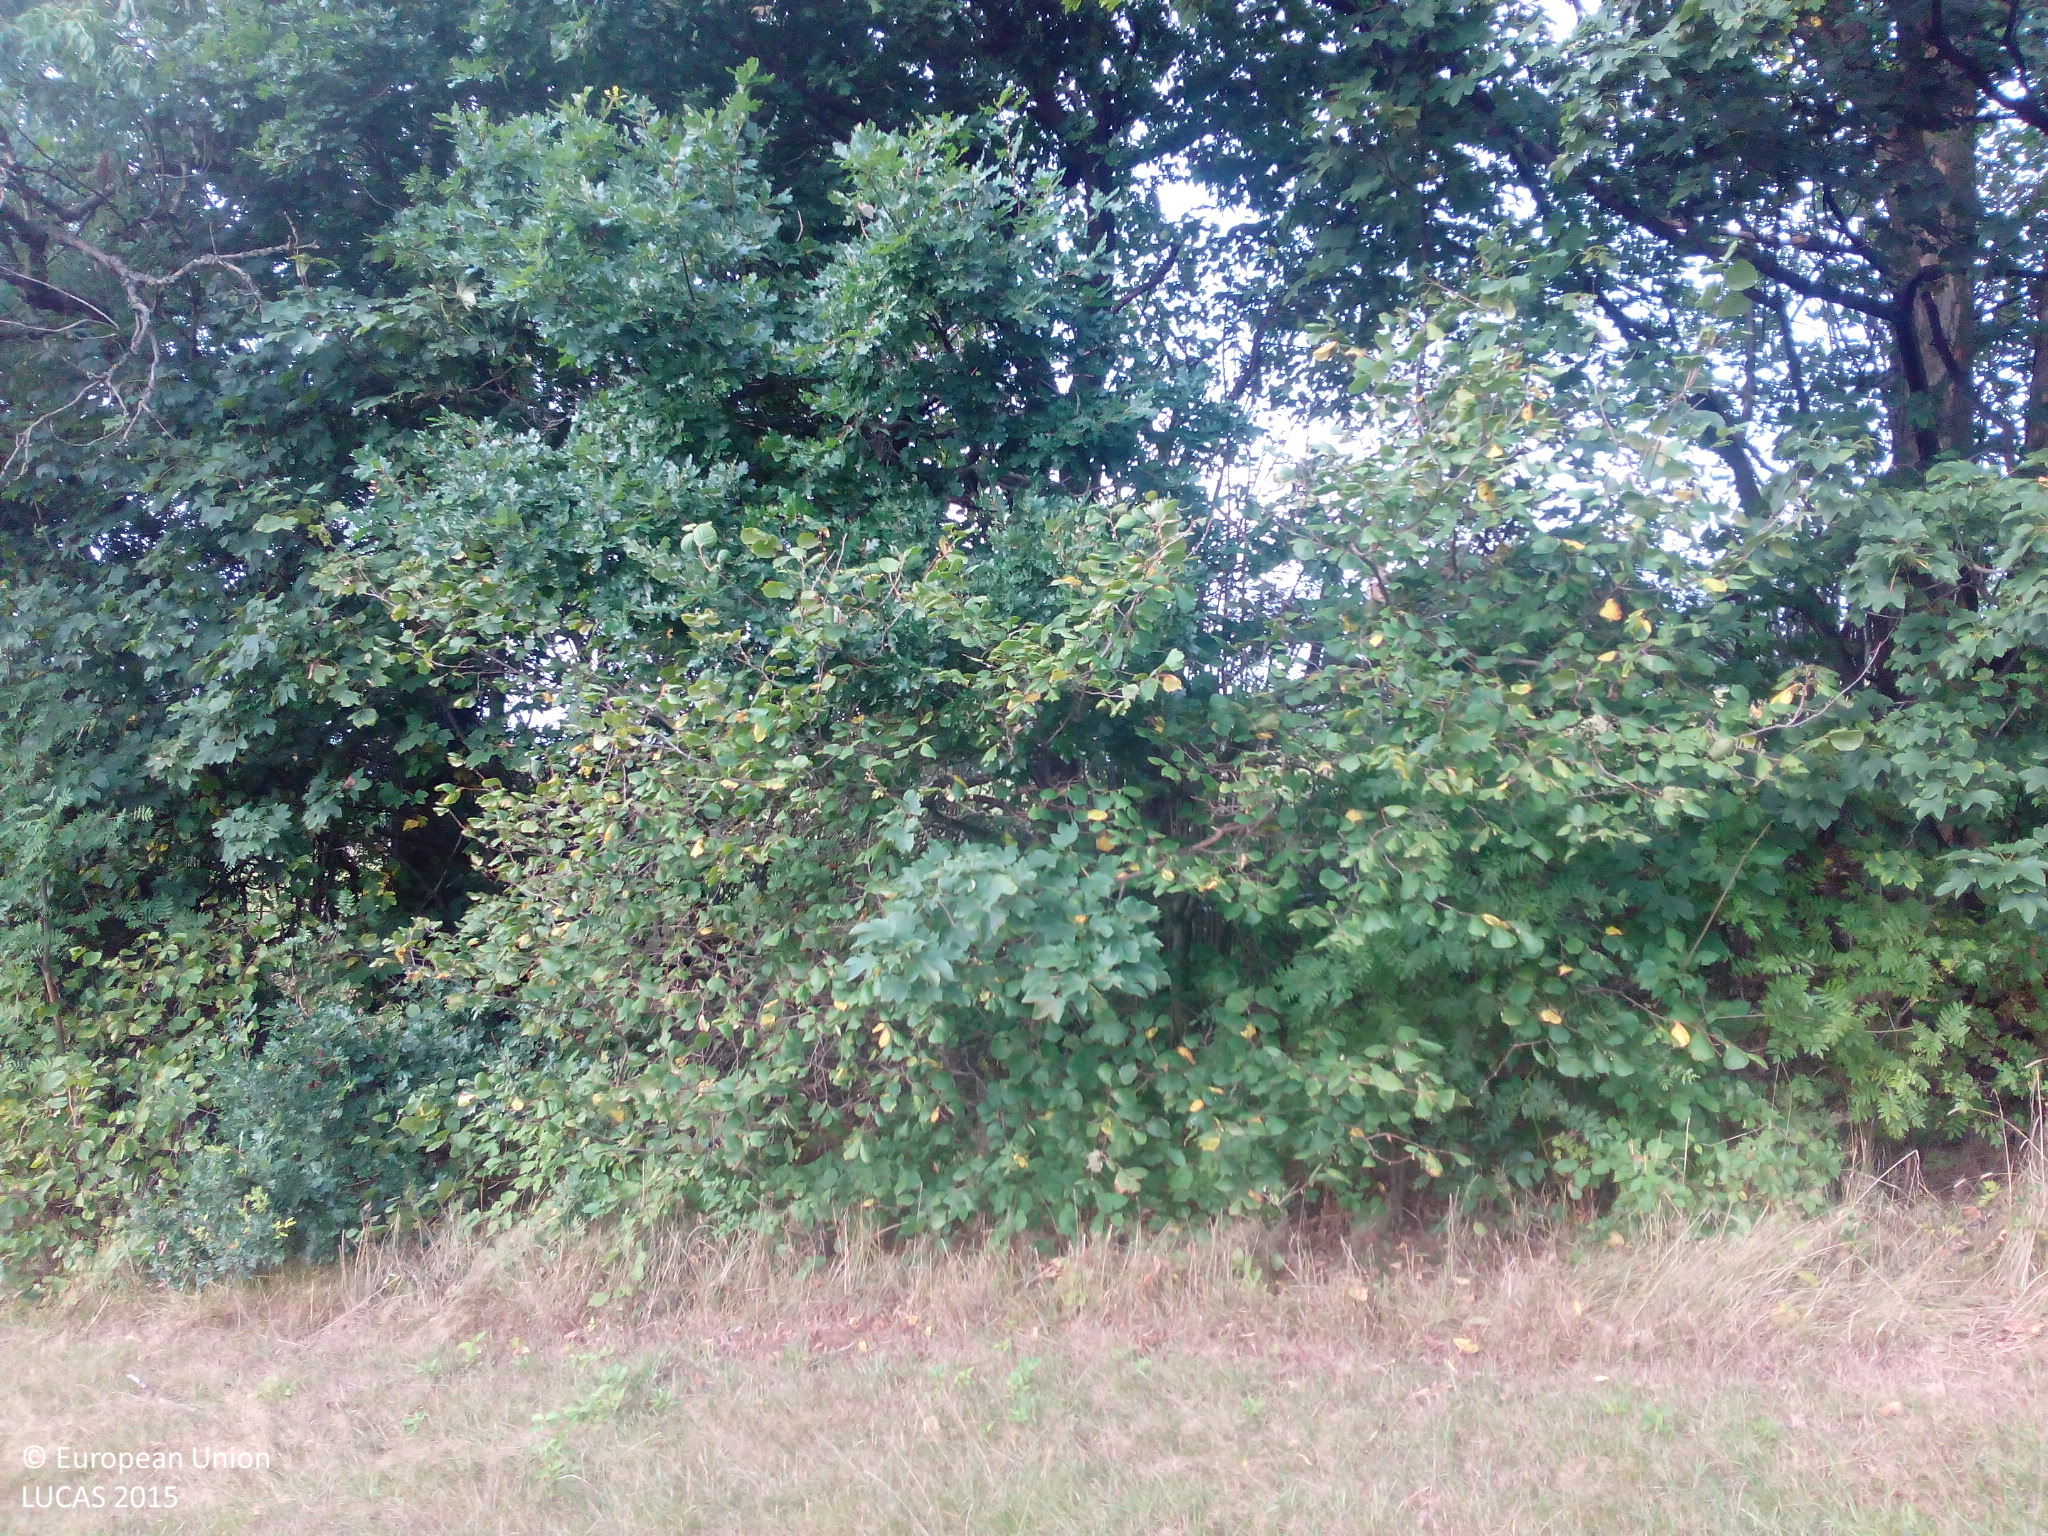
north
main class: Grassland
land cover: Grassland without tree/shrub cover
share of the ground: > 75 %
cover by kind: herbaceous plants 100 %
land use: Agriculture (excluding fallow land and kitchen gardens)
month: August
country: DE
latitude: 50.8345
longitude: 13.9910
